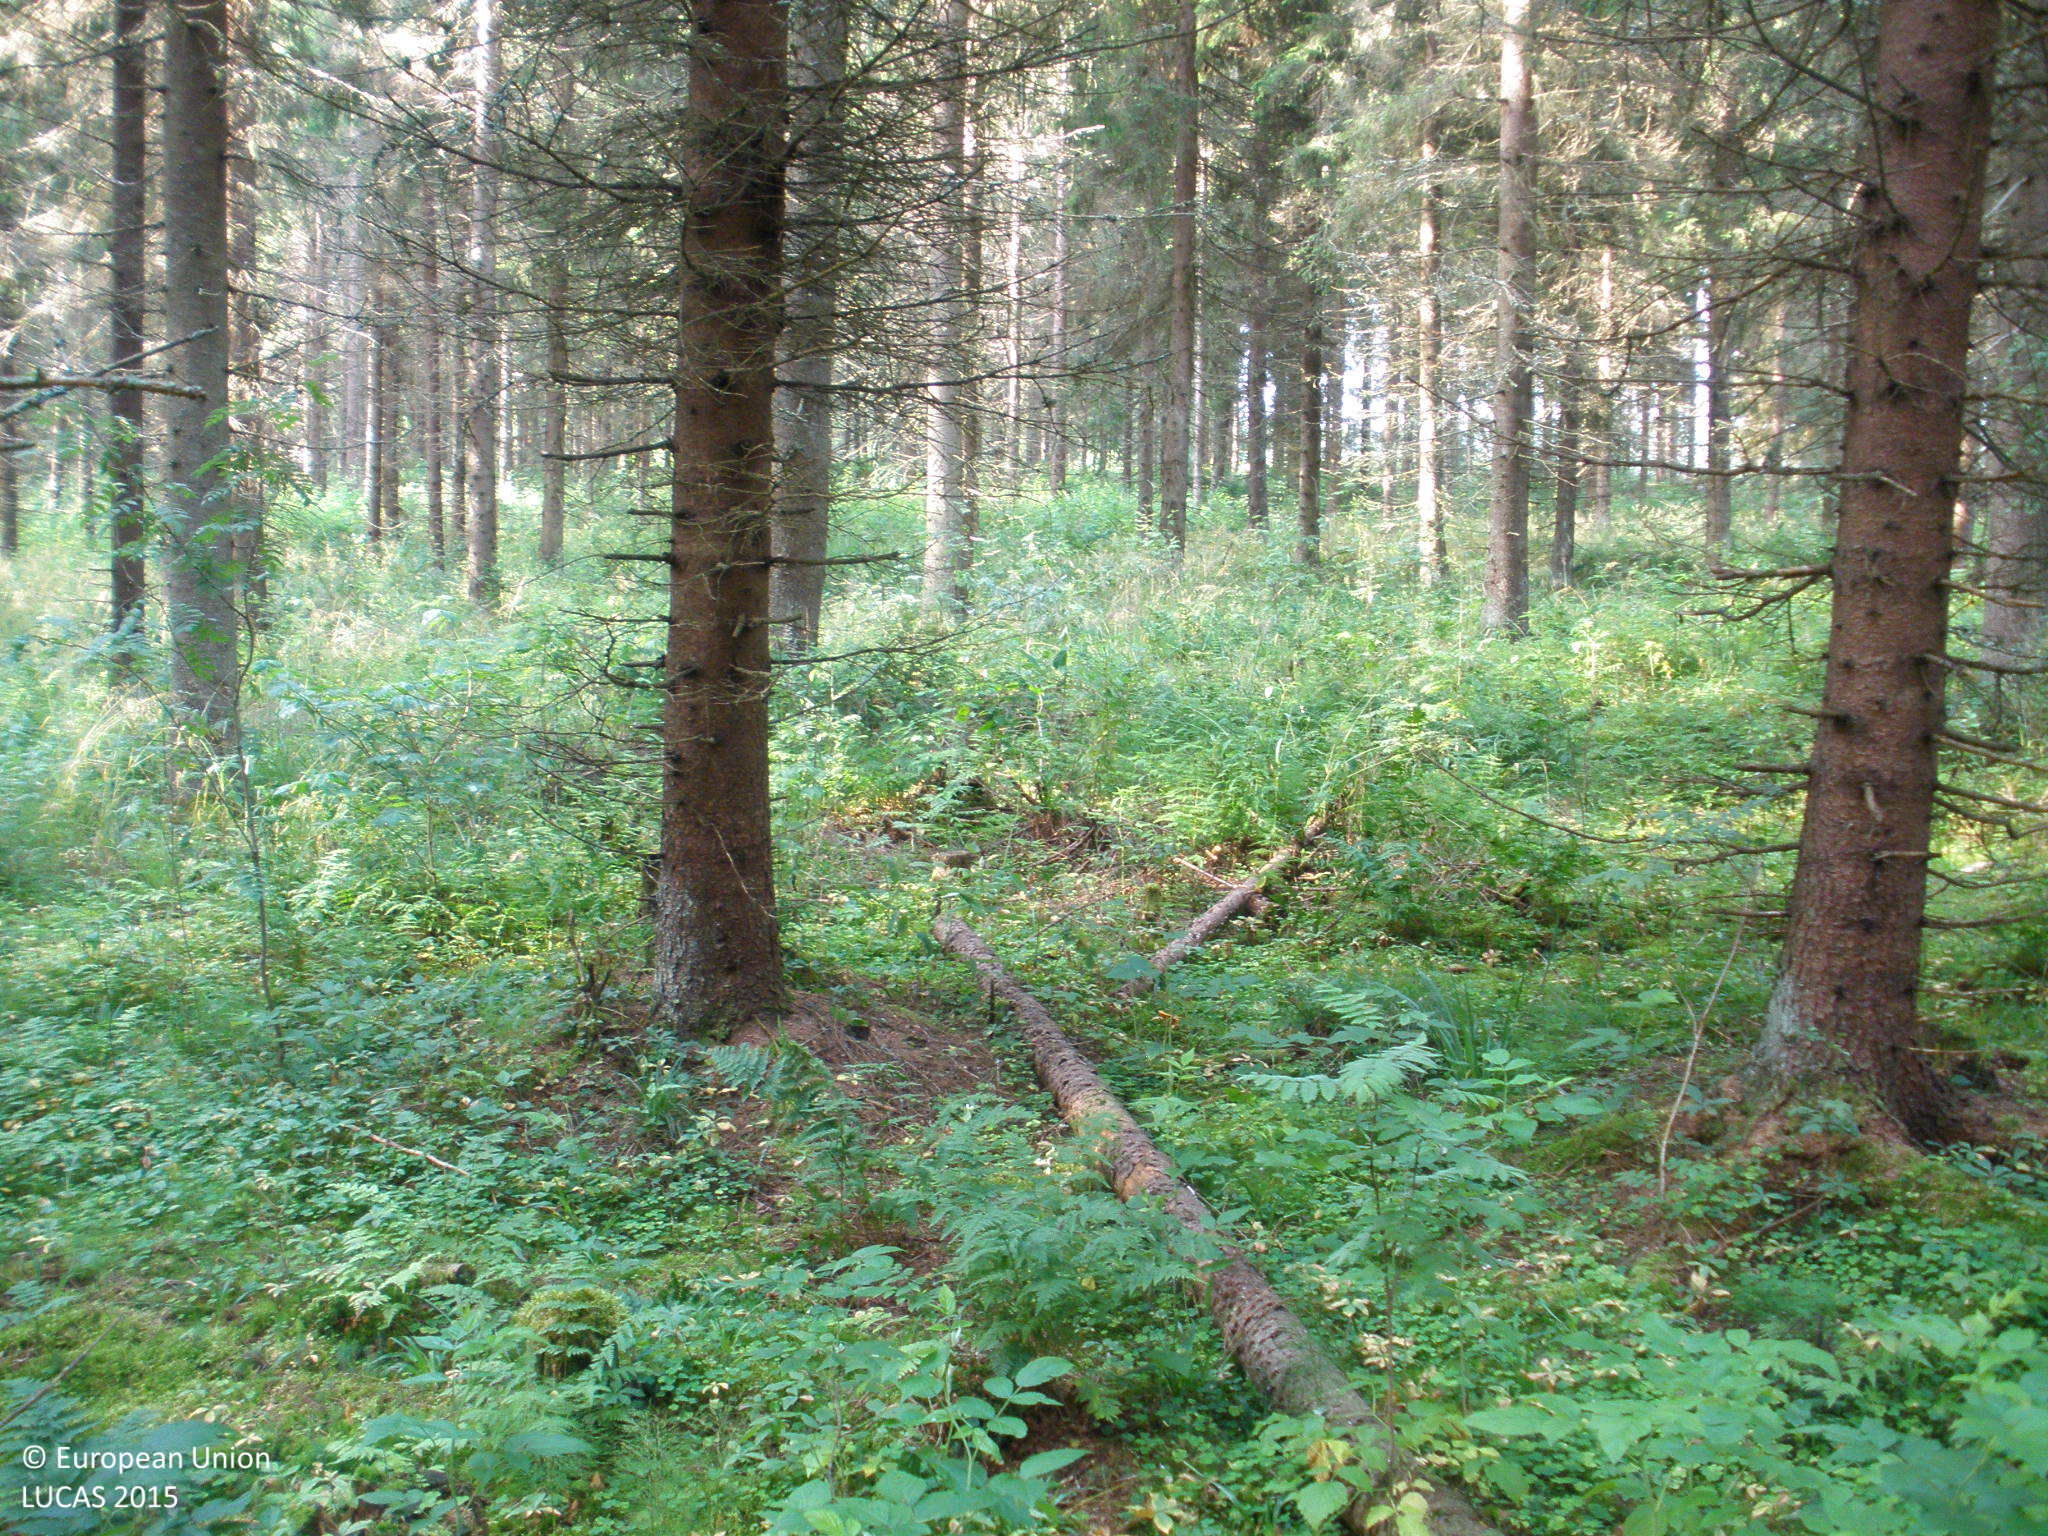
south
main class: Woodland
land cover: Spruce dominated coniferous woodland
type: boreal forest
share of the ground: > 75 %
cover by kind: coniferous forest trees 85 %, lichens and mosses 10 %, herbaceous plants 5 %
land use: Forestry
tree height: > 5 m
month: July
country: FI
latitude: 61.1380
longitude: 24.9879
